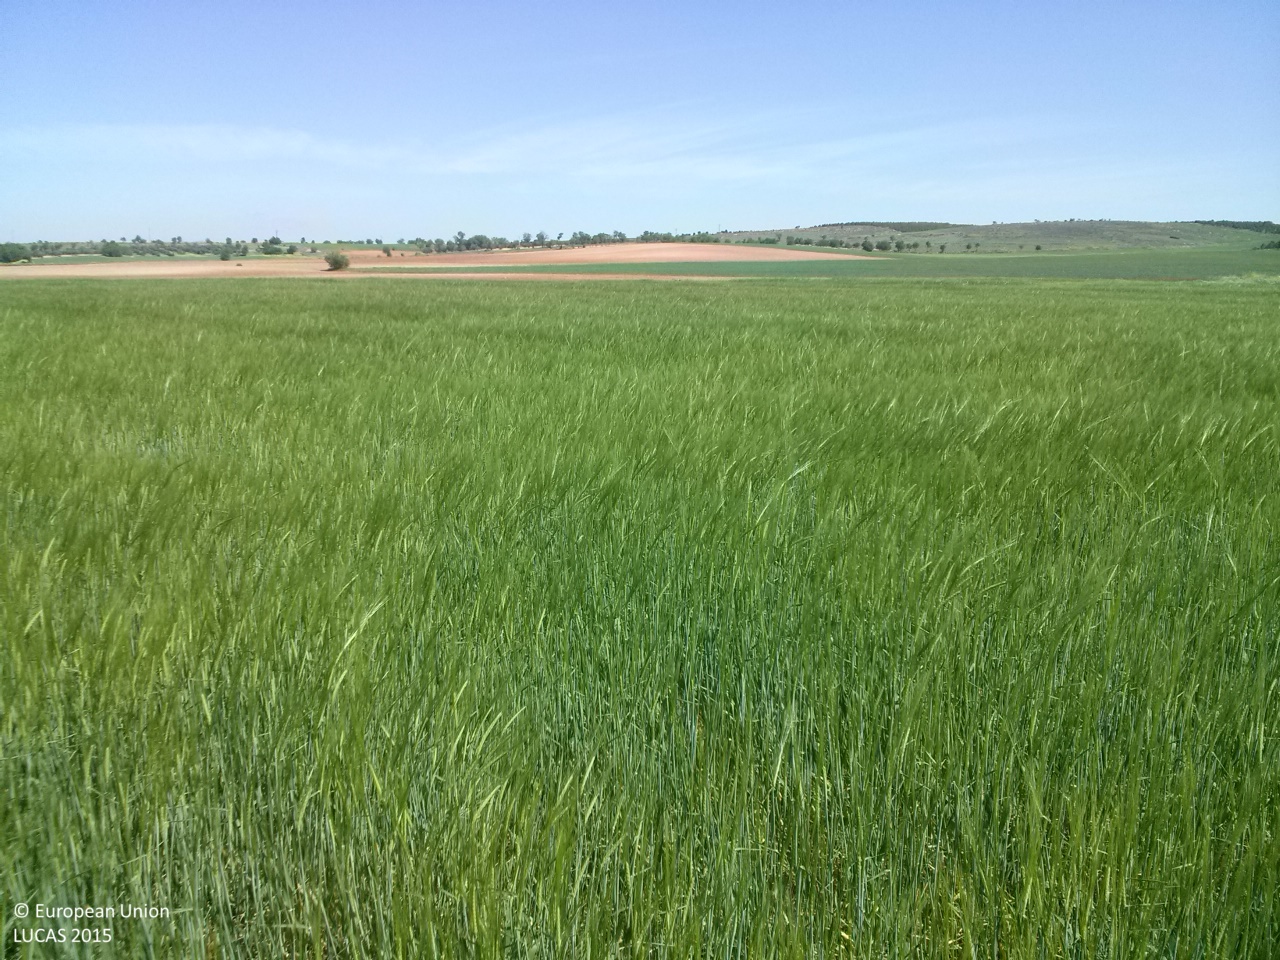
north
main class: Cropland
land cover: Barley
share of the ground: > 75 %
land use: Agriculture (excluding fallow land and kitchen gardens)
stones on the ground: 10 - 25 %
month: May
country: ES
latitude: 39.7933
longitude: -2.7829
